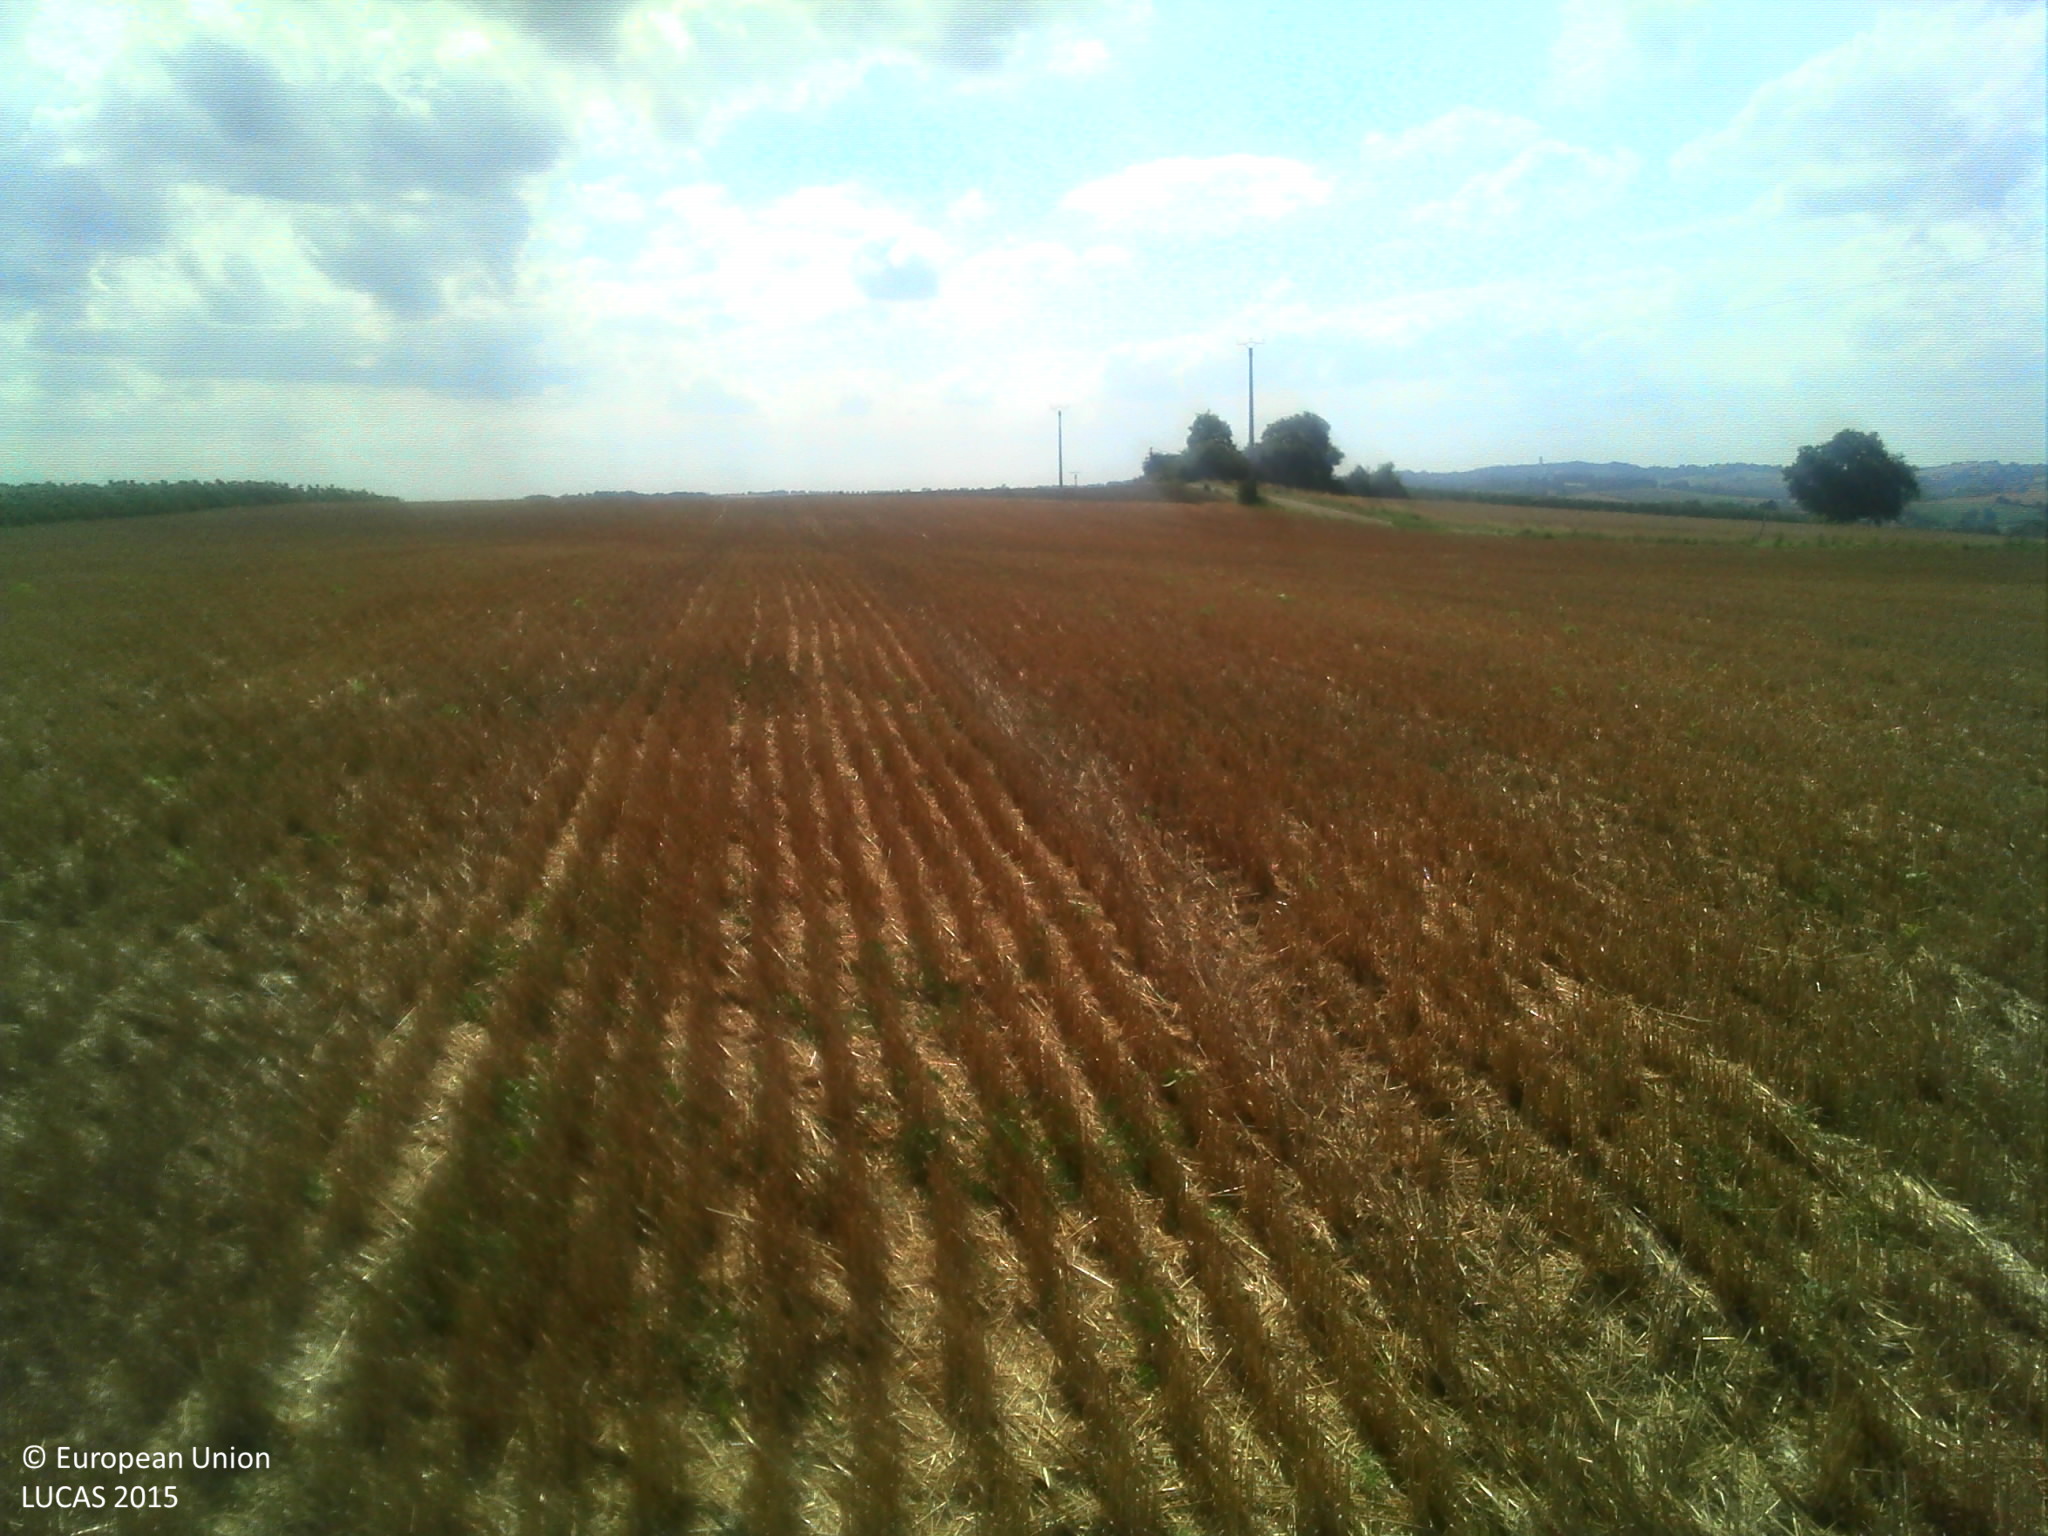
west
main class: Cropland
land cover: Common wheat
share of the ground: > 75 %
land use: Agriculture (excluding fallow land and kitchen gardens)
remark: Harvested field
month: July
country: FR
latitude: 44.0163
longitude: 0.6276
